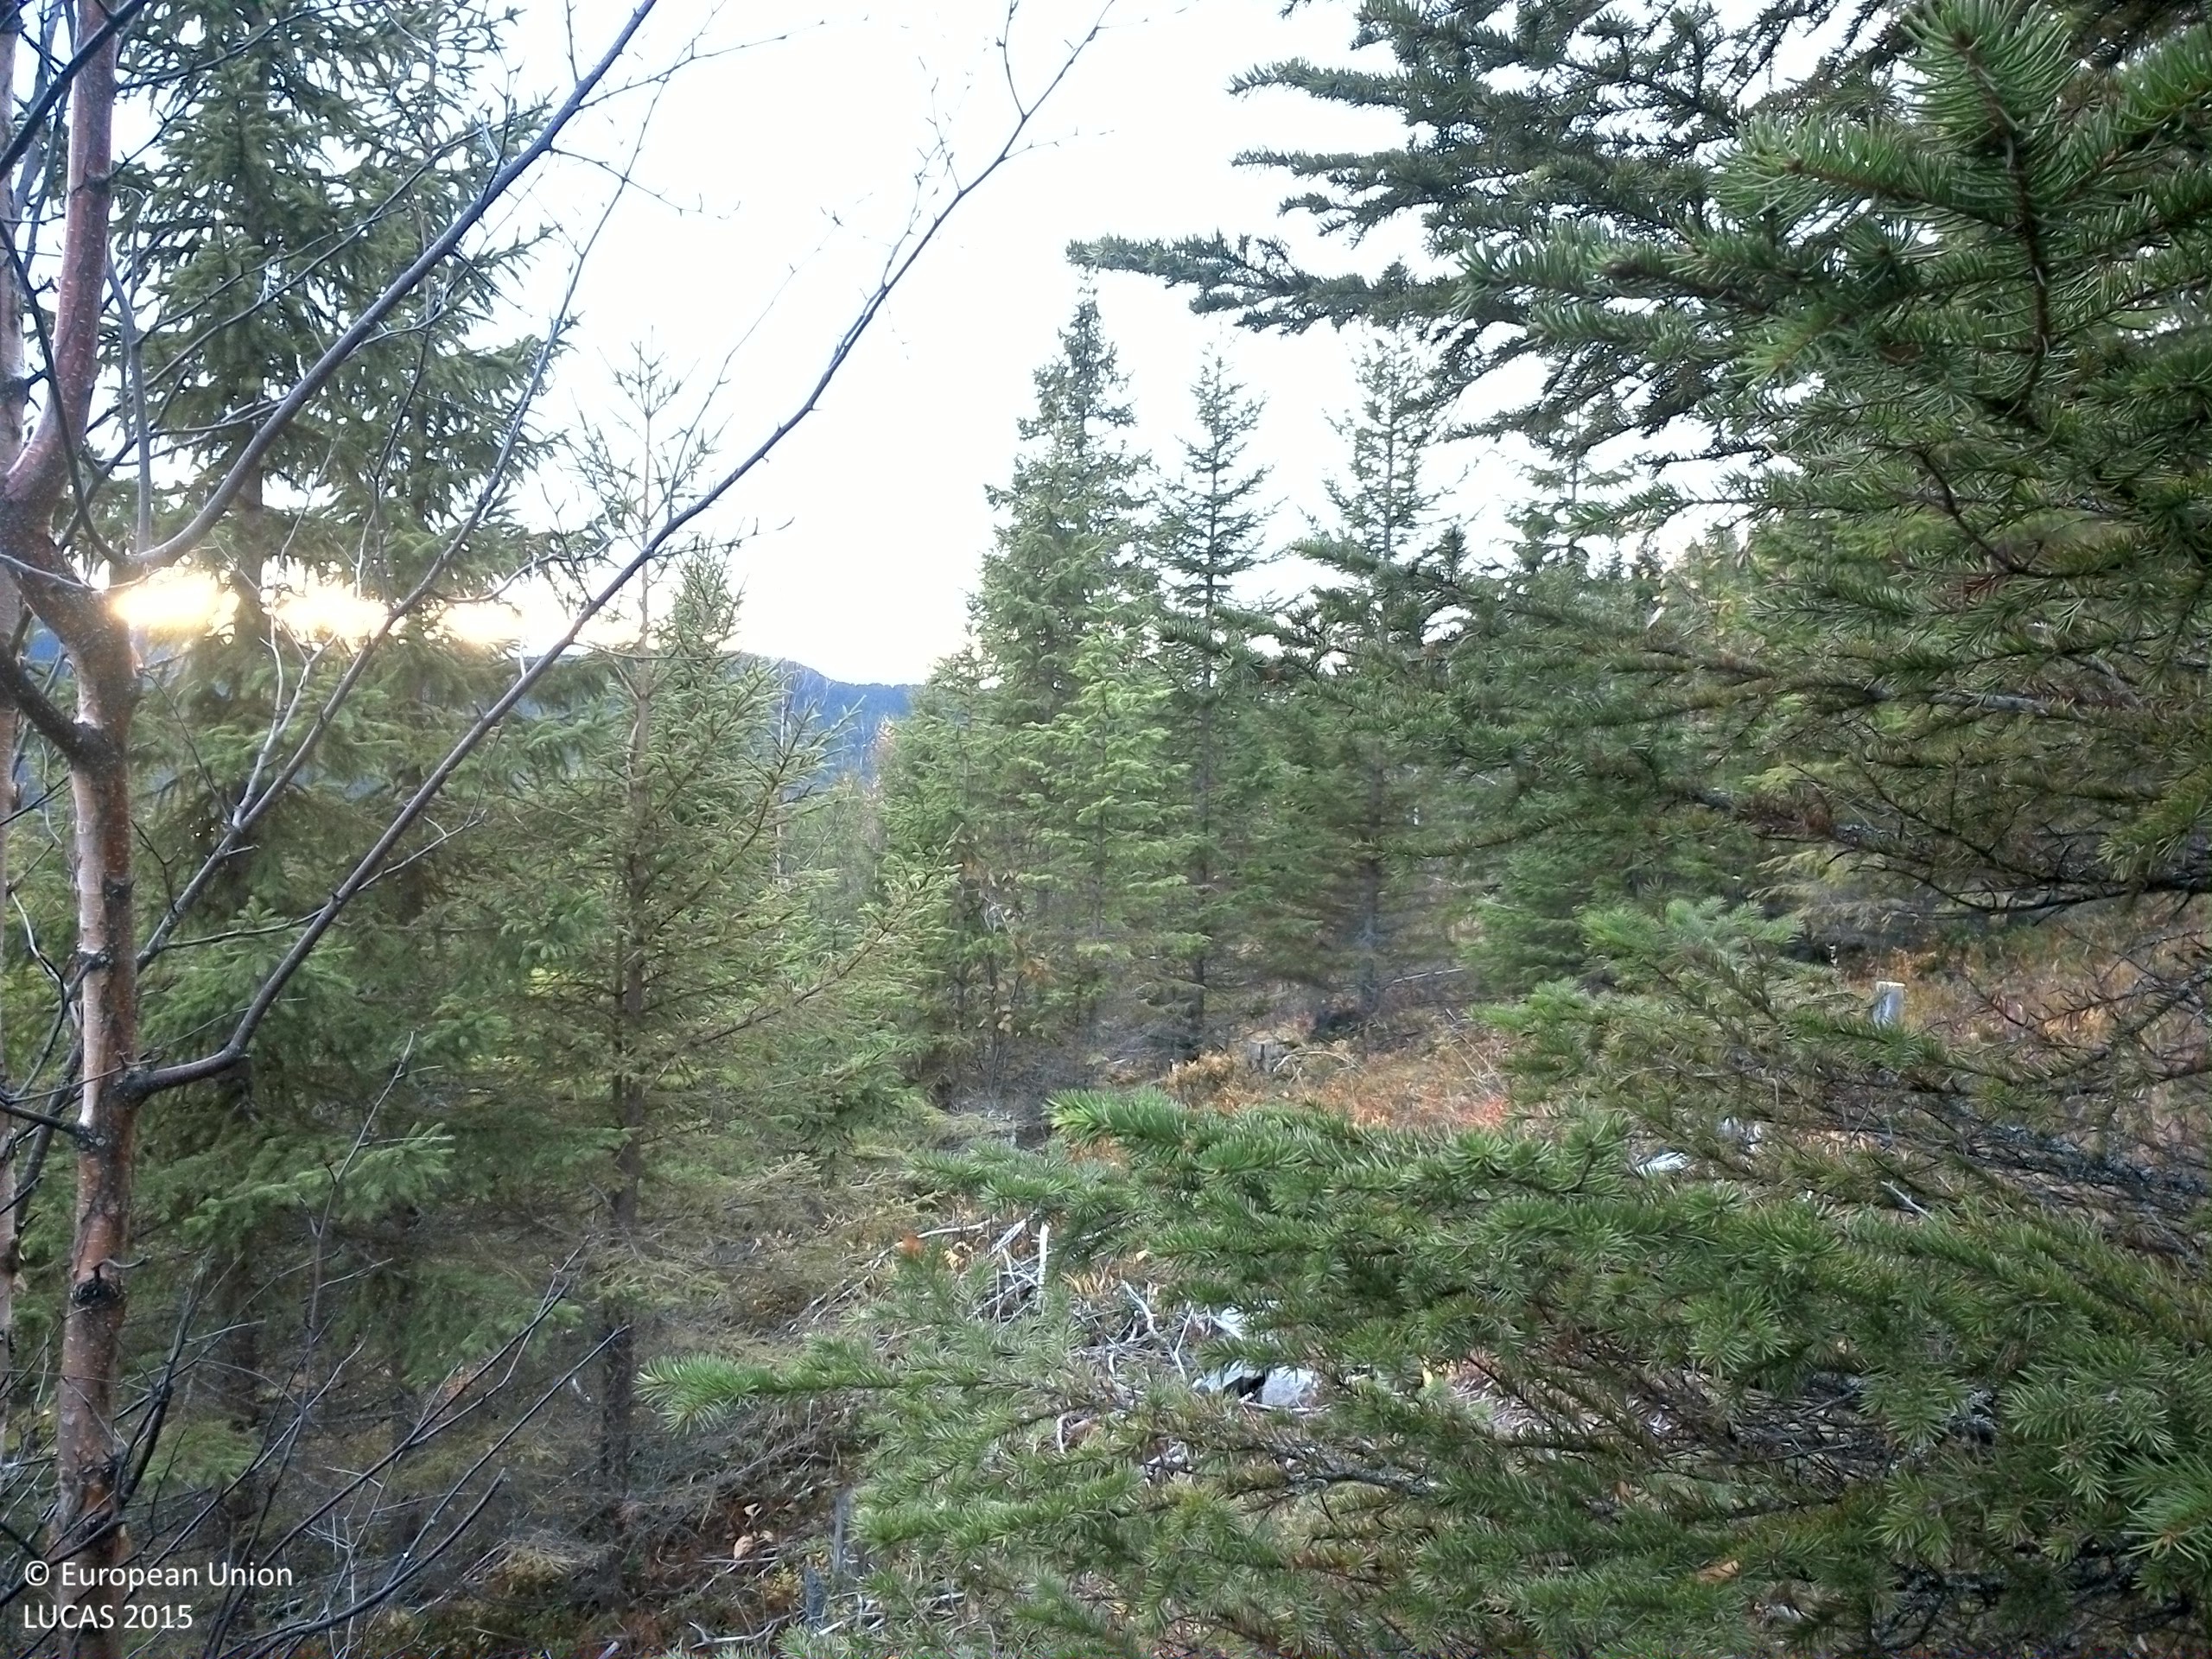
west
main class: Woodland
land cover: Spruce dominated mixed woodland
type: boreal forest
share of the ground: 50 - 75 %
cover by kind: coniferous forest trees 35 %, shrubs 35 %, broadleaved forest trees 15 %, lichens and mosses 10 %, consolidated bare surface 5 %
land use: Forestry
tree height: > 5 m
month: October
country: SE
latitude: 64.3449
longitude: 14.7554
